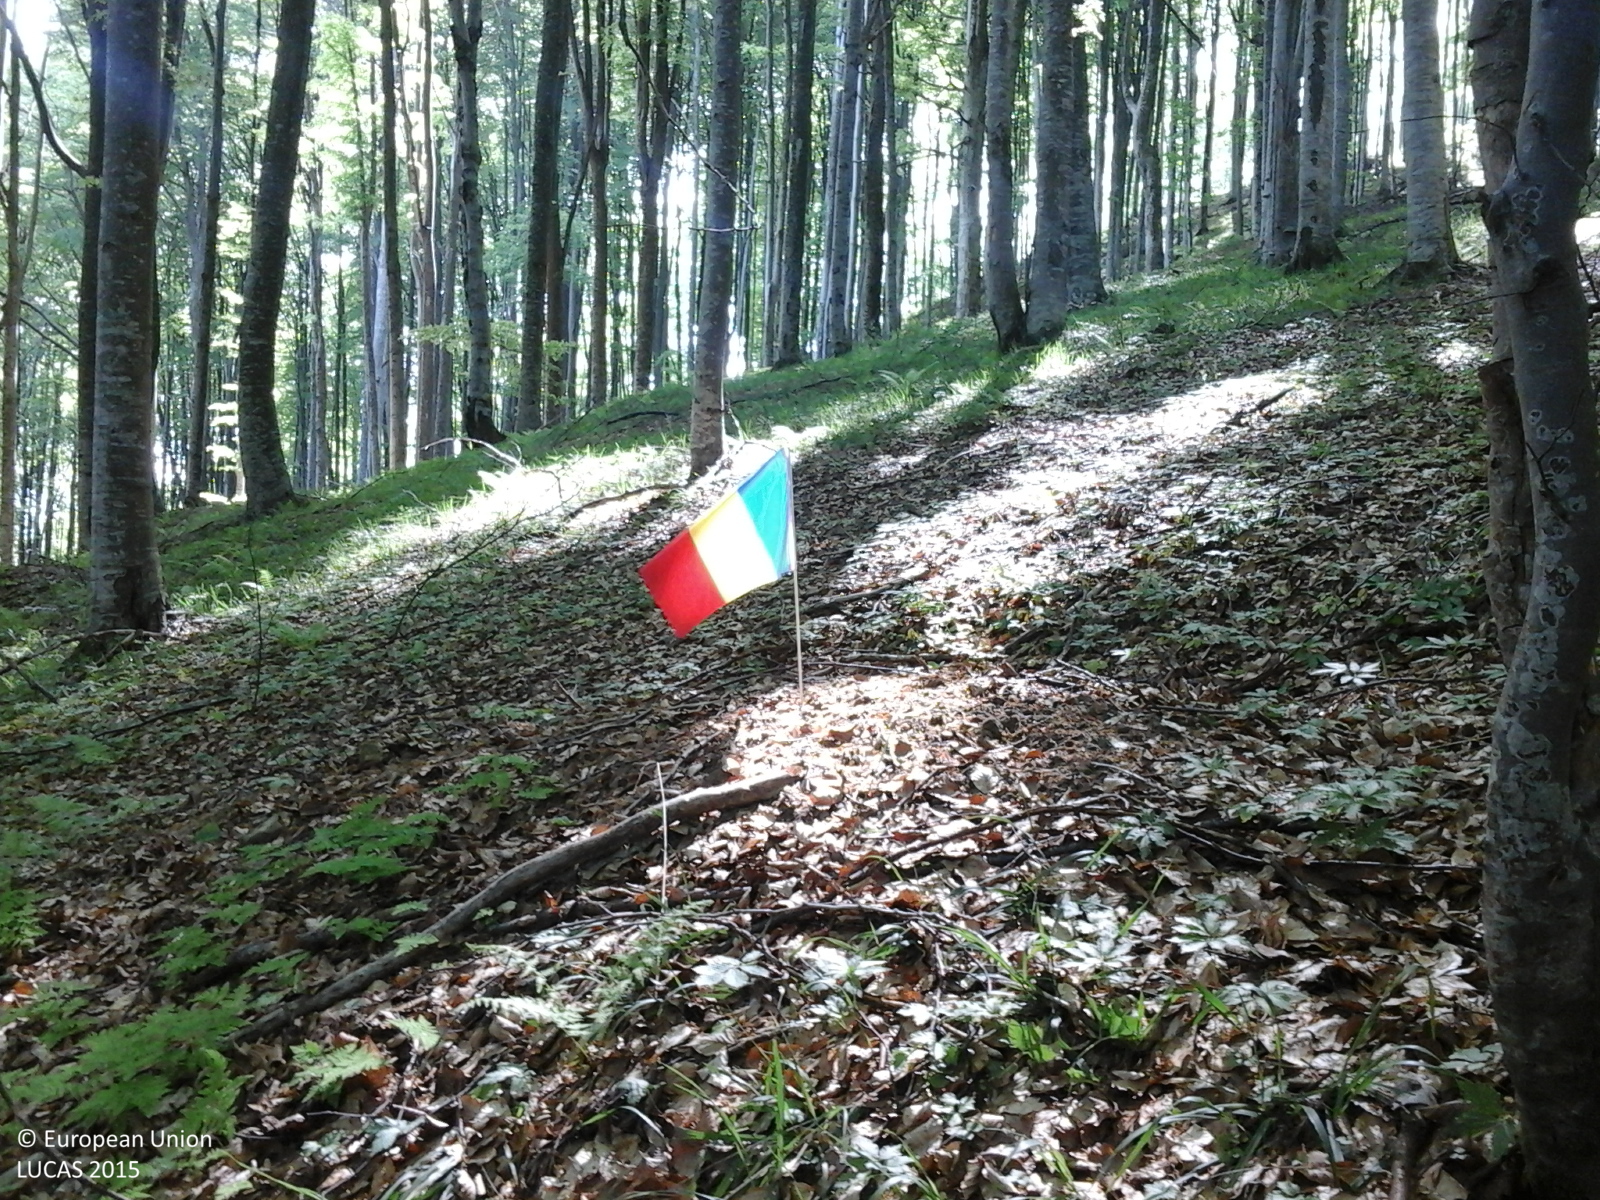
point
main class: Woodland
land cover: Broadleaved woodland
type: beech forest
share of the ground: > 75 %
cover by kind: broadleaved forest trees 100 %
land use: Forestry
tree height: > 5 m
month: May
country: RO
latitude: 45.7266
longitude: 25.9832
